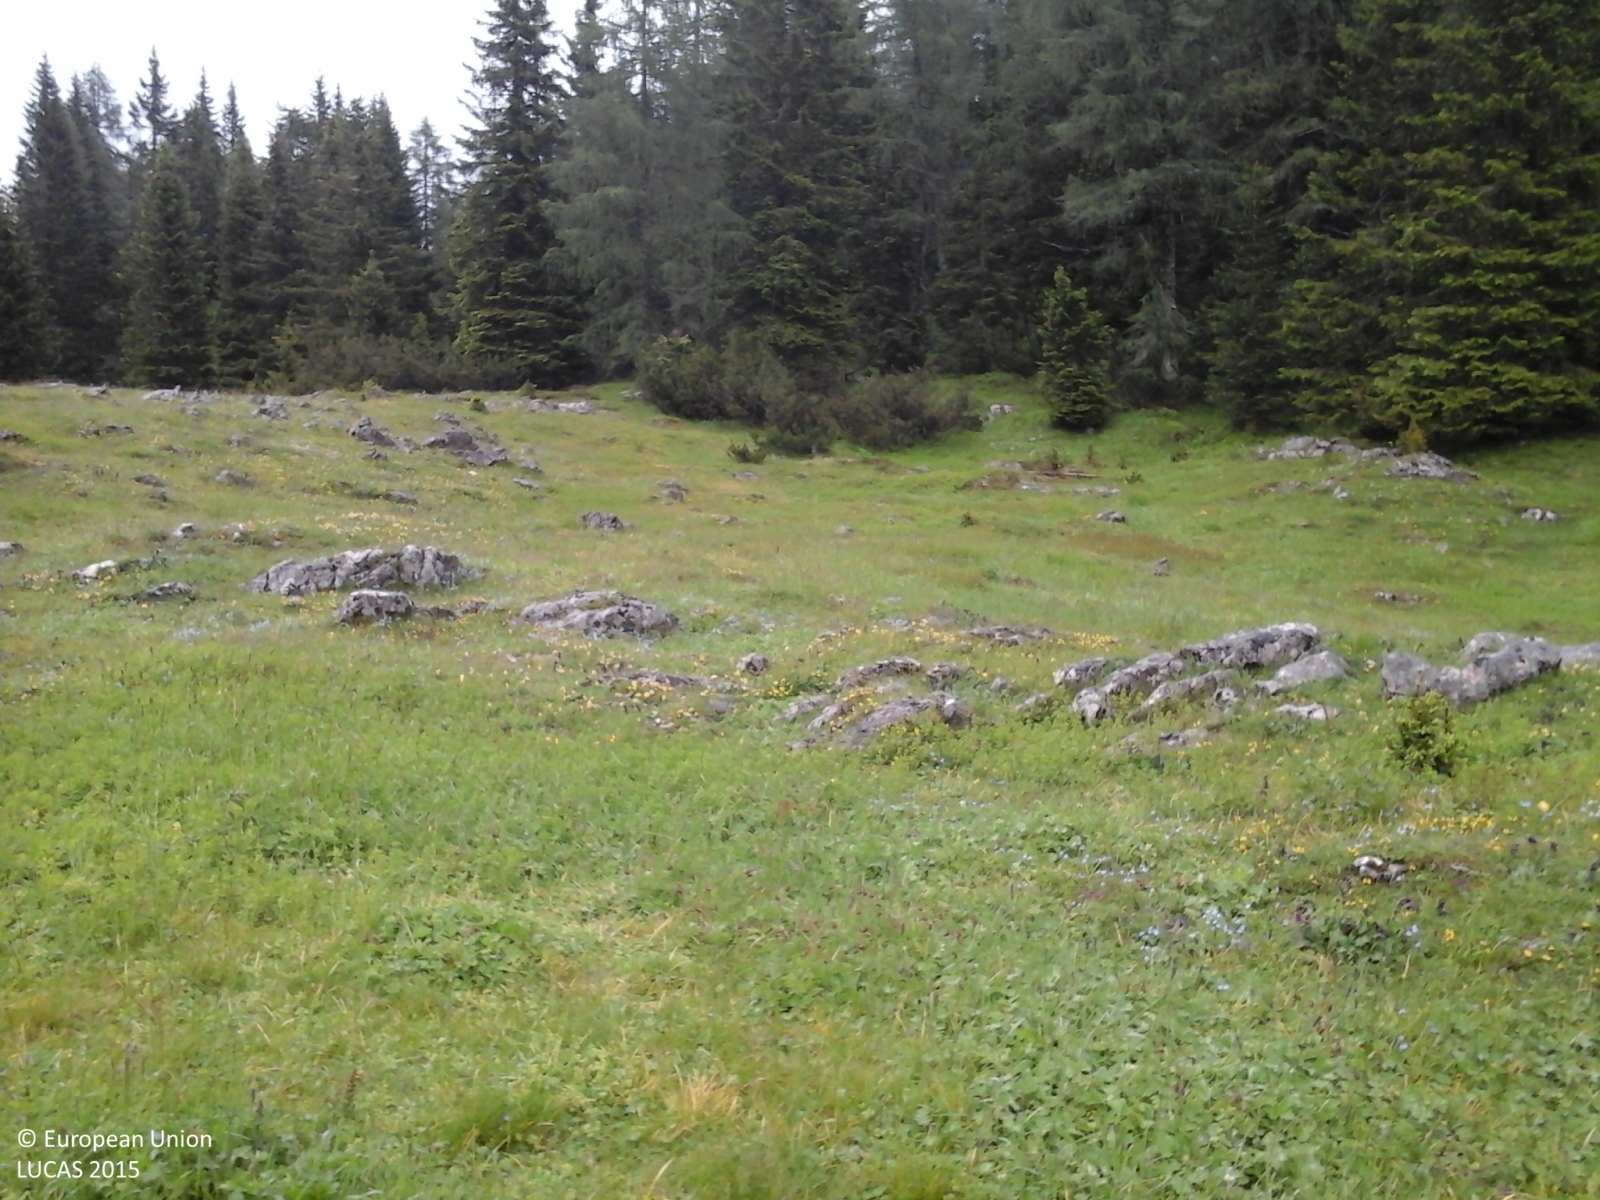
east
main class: Grassland
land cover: Grassland without tree/shrub cover
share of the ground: > 75 %
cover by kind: herbaceous plants 100 %
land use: Agriculture (excluding fallow land and kitchen gardens)
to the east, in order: Grassland without tree/shrub cover; Spruce dominated coniferous woodland; Grassland with sparse tree/shrub cover; Grassland without tree/shrub cover; Spruce dominated coniferous woodland
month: June
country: IT
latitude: 45.9799
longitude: 11.5338
